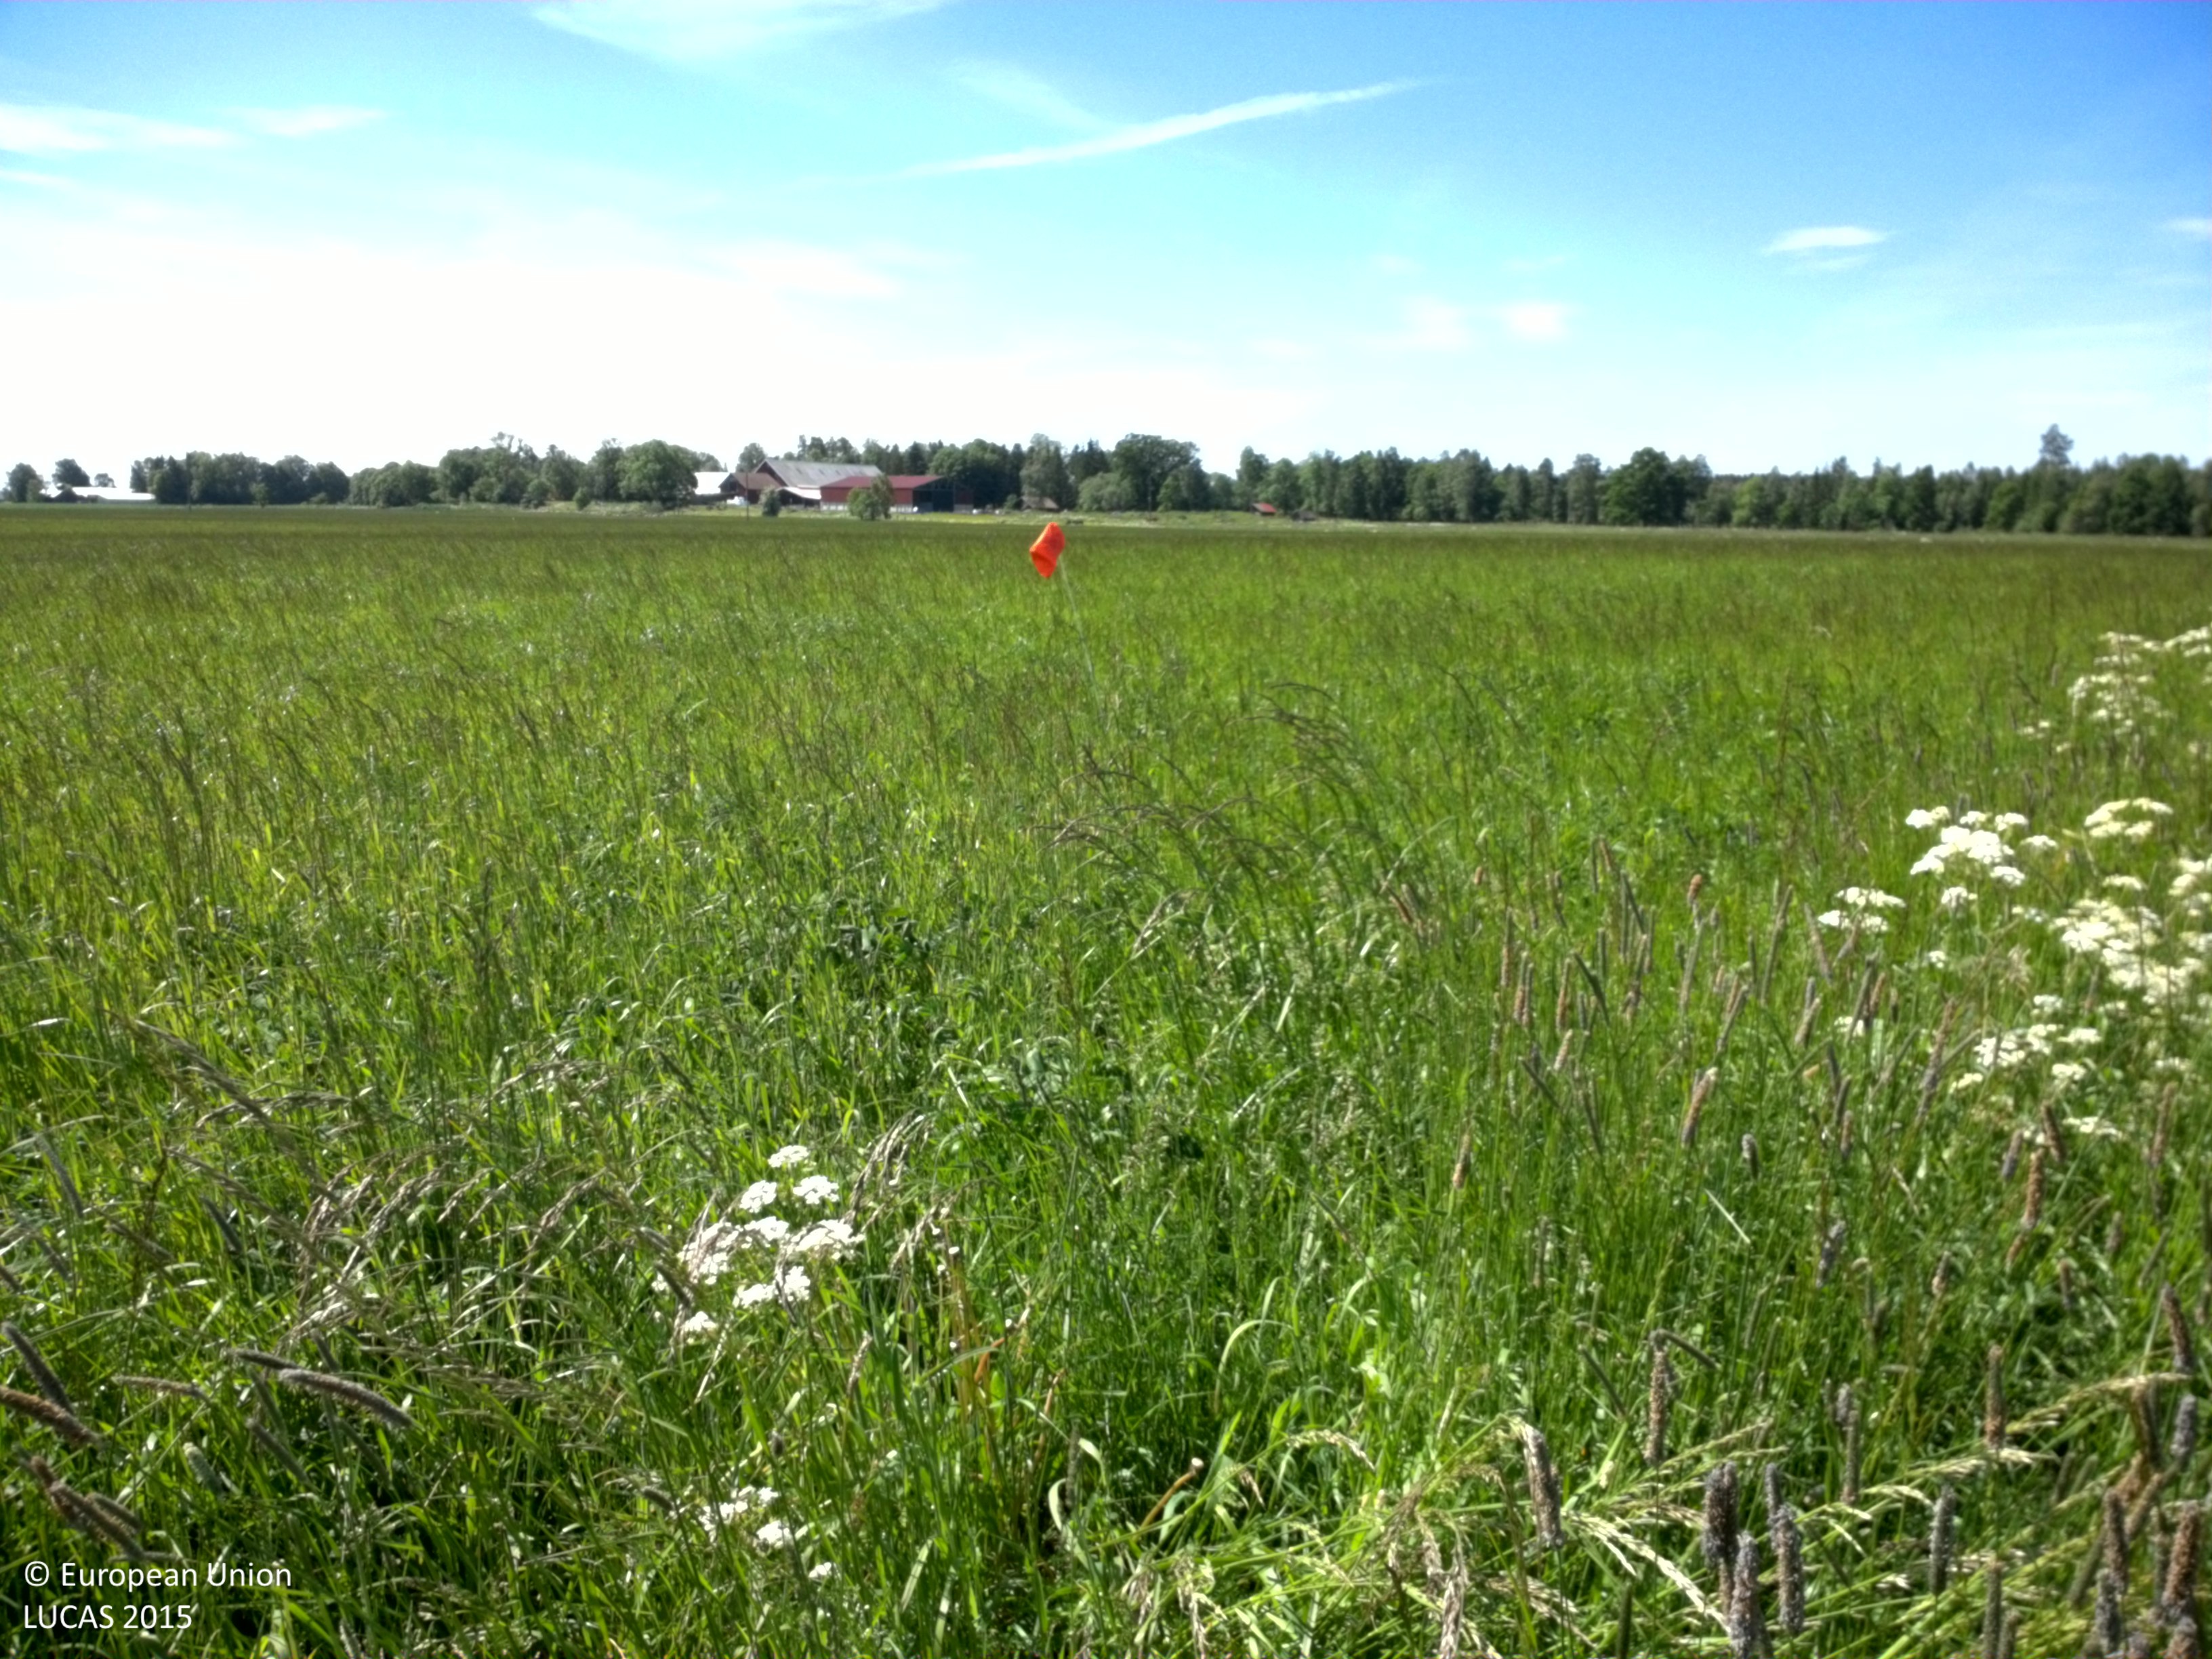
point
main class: Cropland
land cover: Other leguminous and mixtures for fodder
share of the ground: > 75 %
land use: Agriculture (excluding fallow land and kitchen gardens)
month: June
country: SE
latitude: 58.4898
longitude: 15.3977
